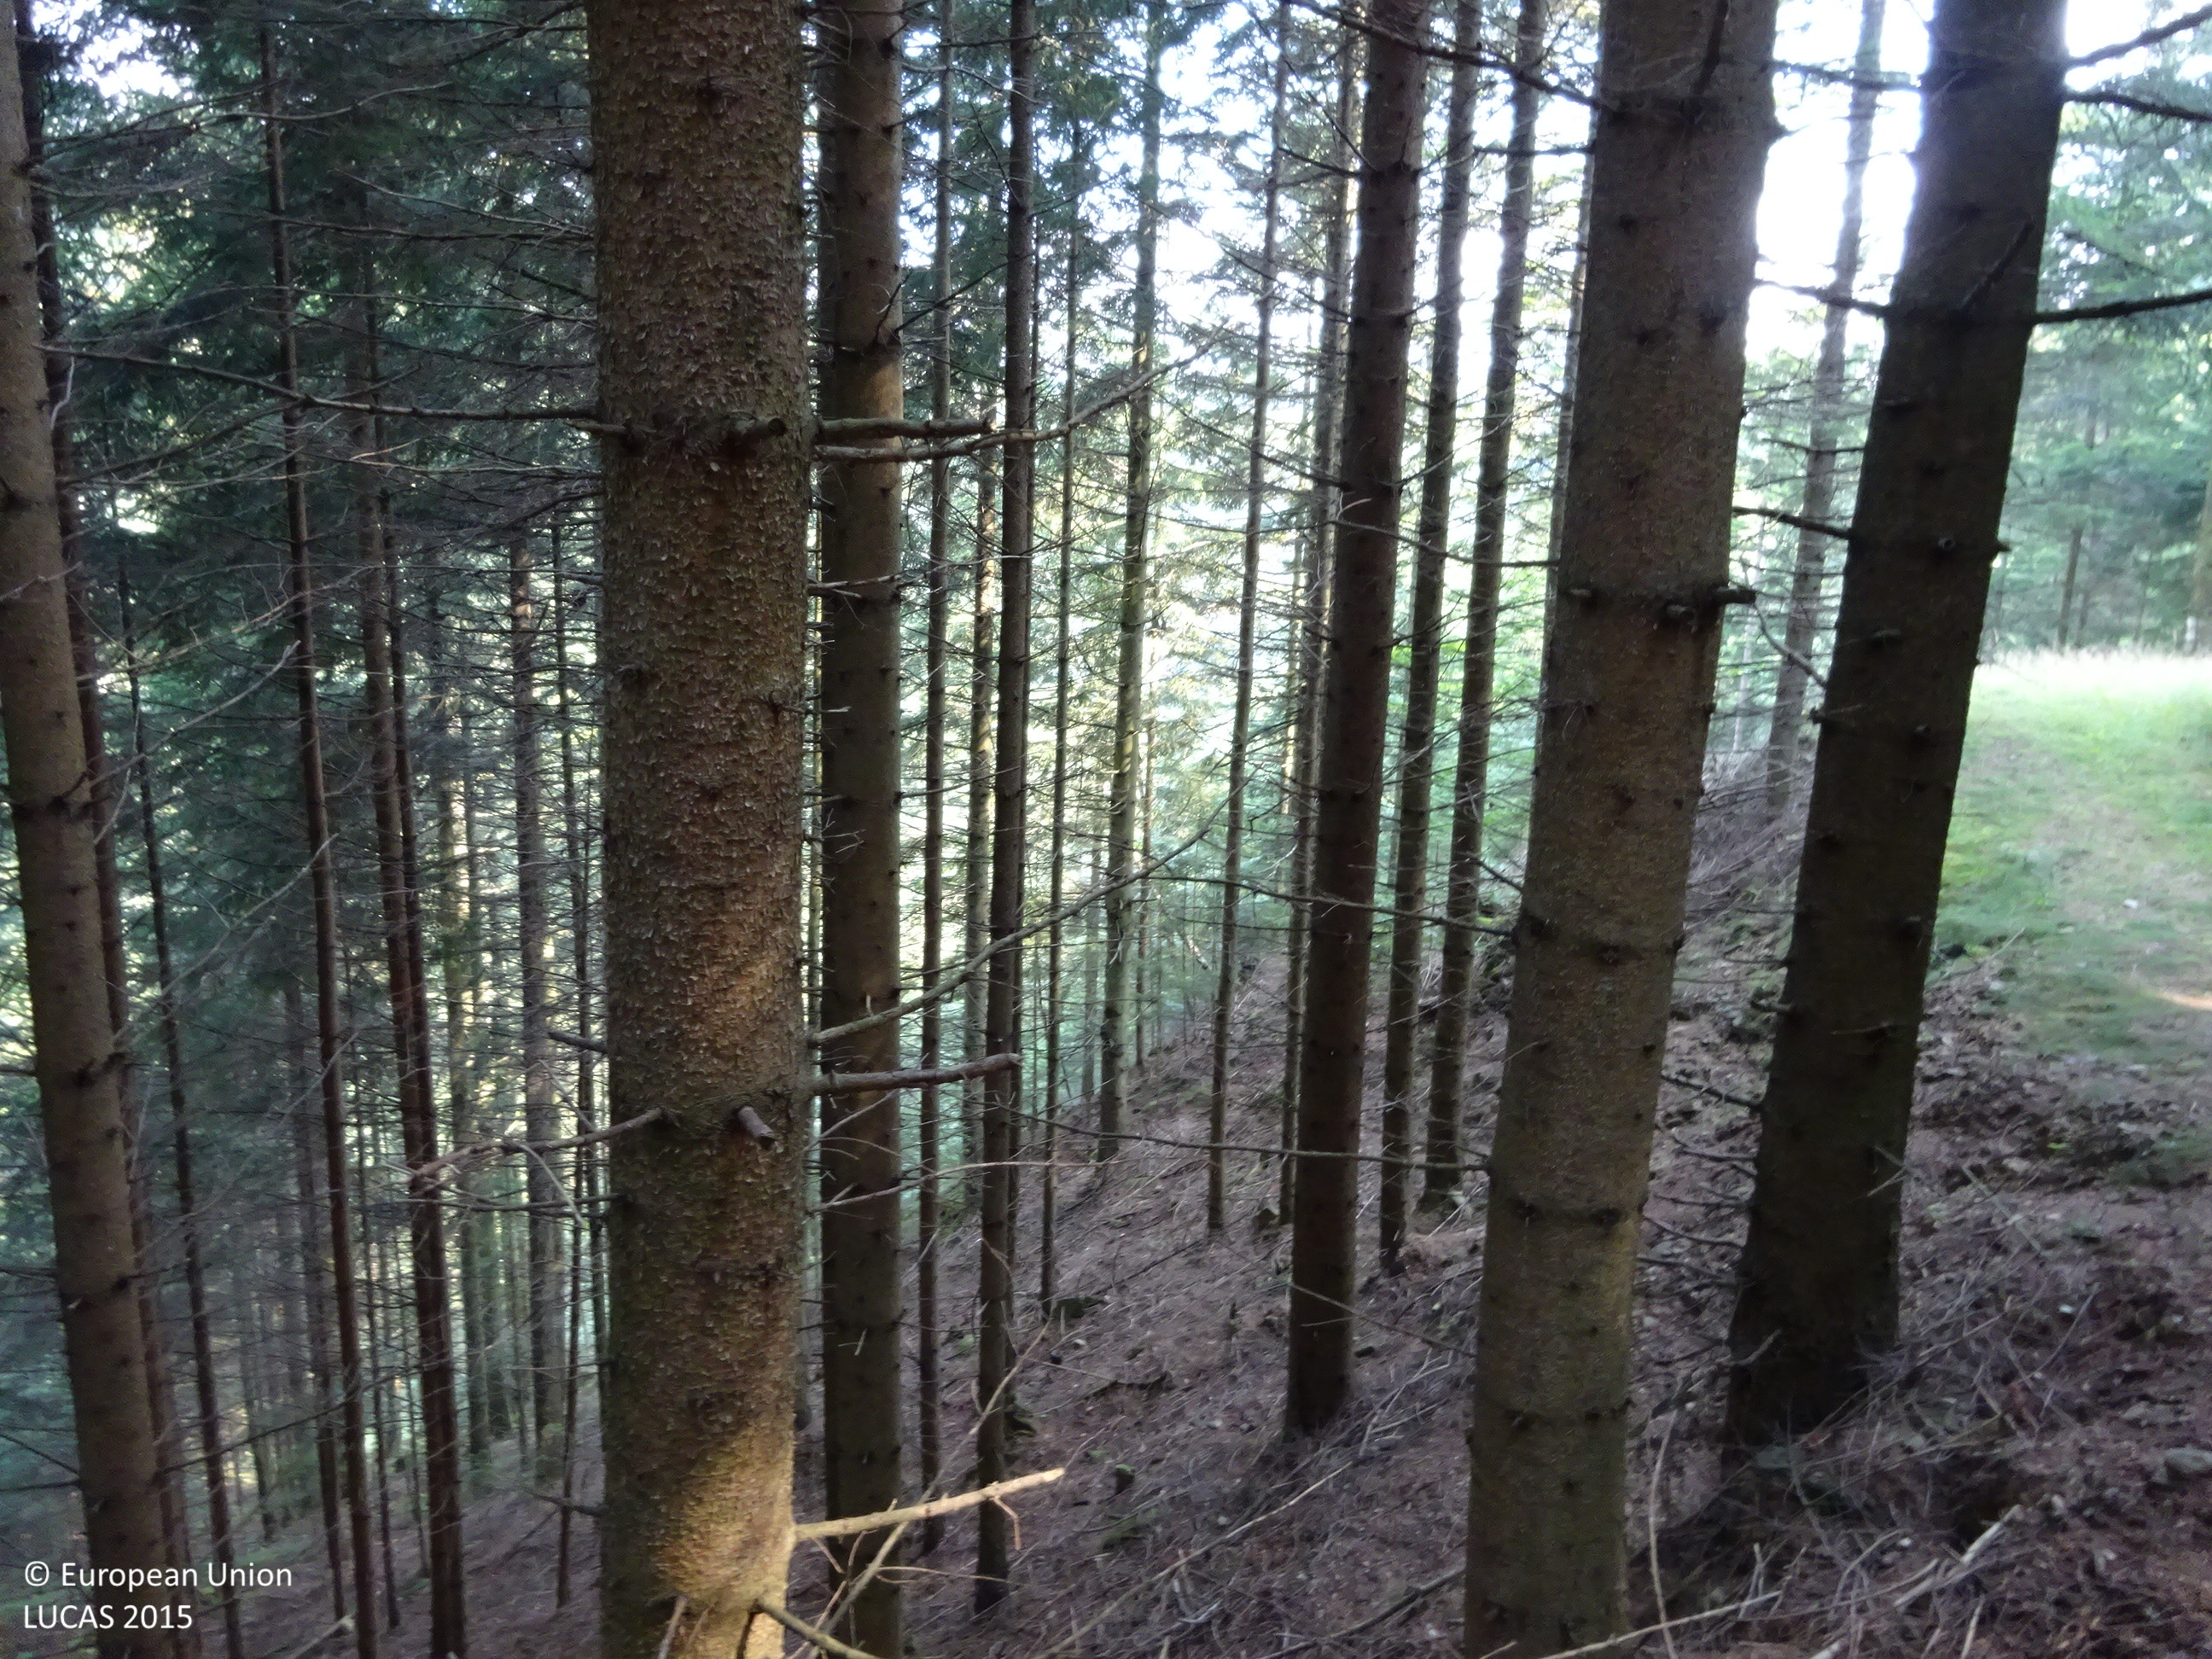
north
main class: Woodland
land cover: Spruce dominated coniferous woodland
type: alpine coniferous forest
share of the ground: > 75 %
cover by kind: coniferous forest trees 95 %, unconsolidated bare surface 5 %
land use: Forestry
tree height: > 5 m
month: August
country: AT
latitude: 47.3899
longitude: 15.7109
